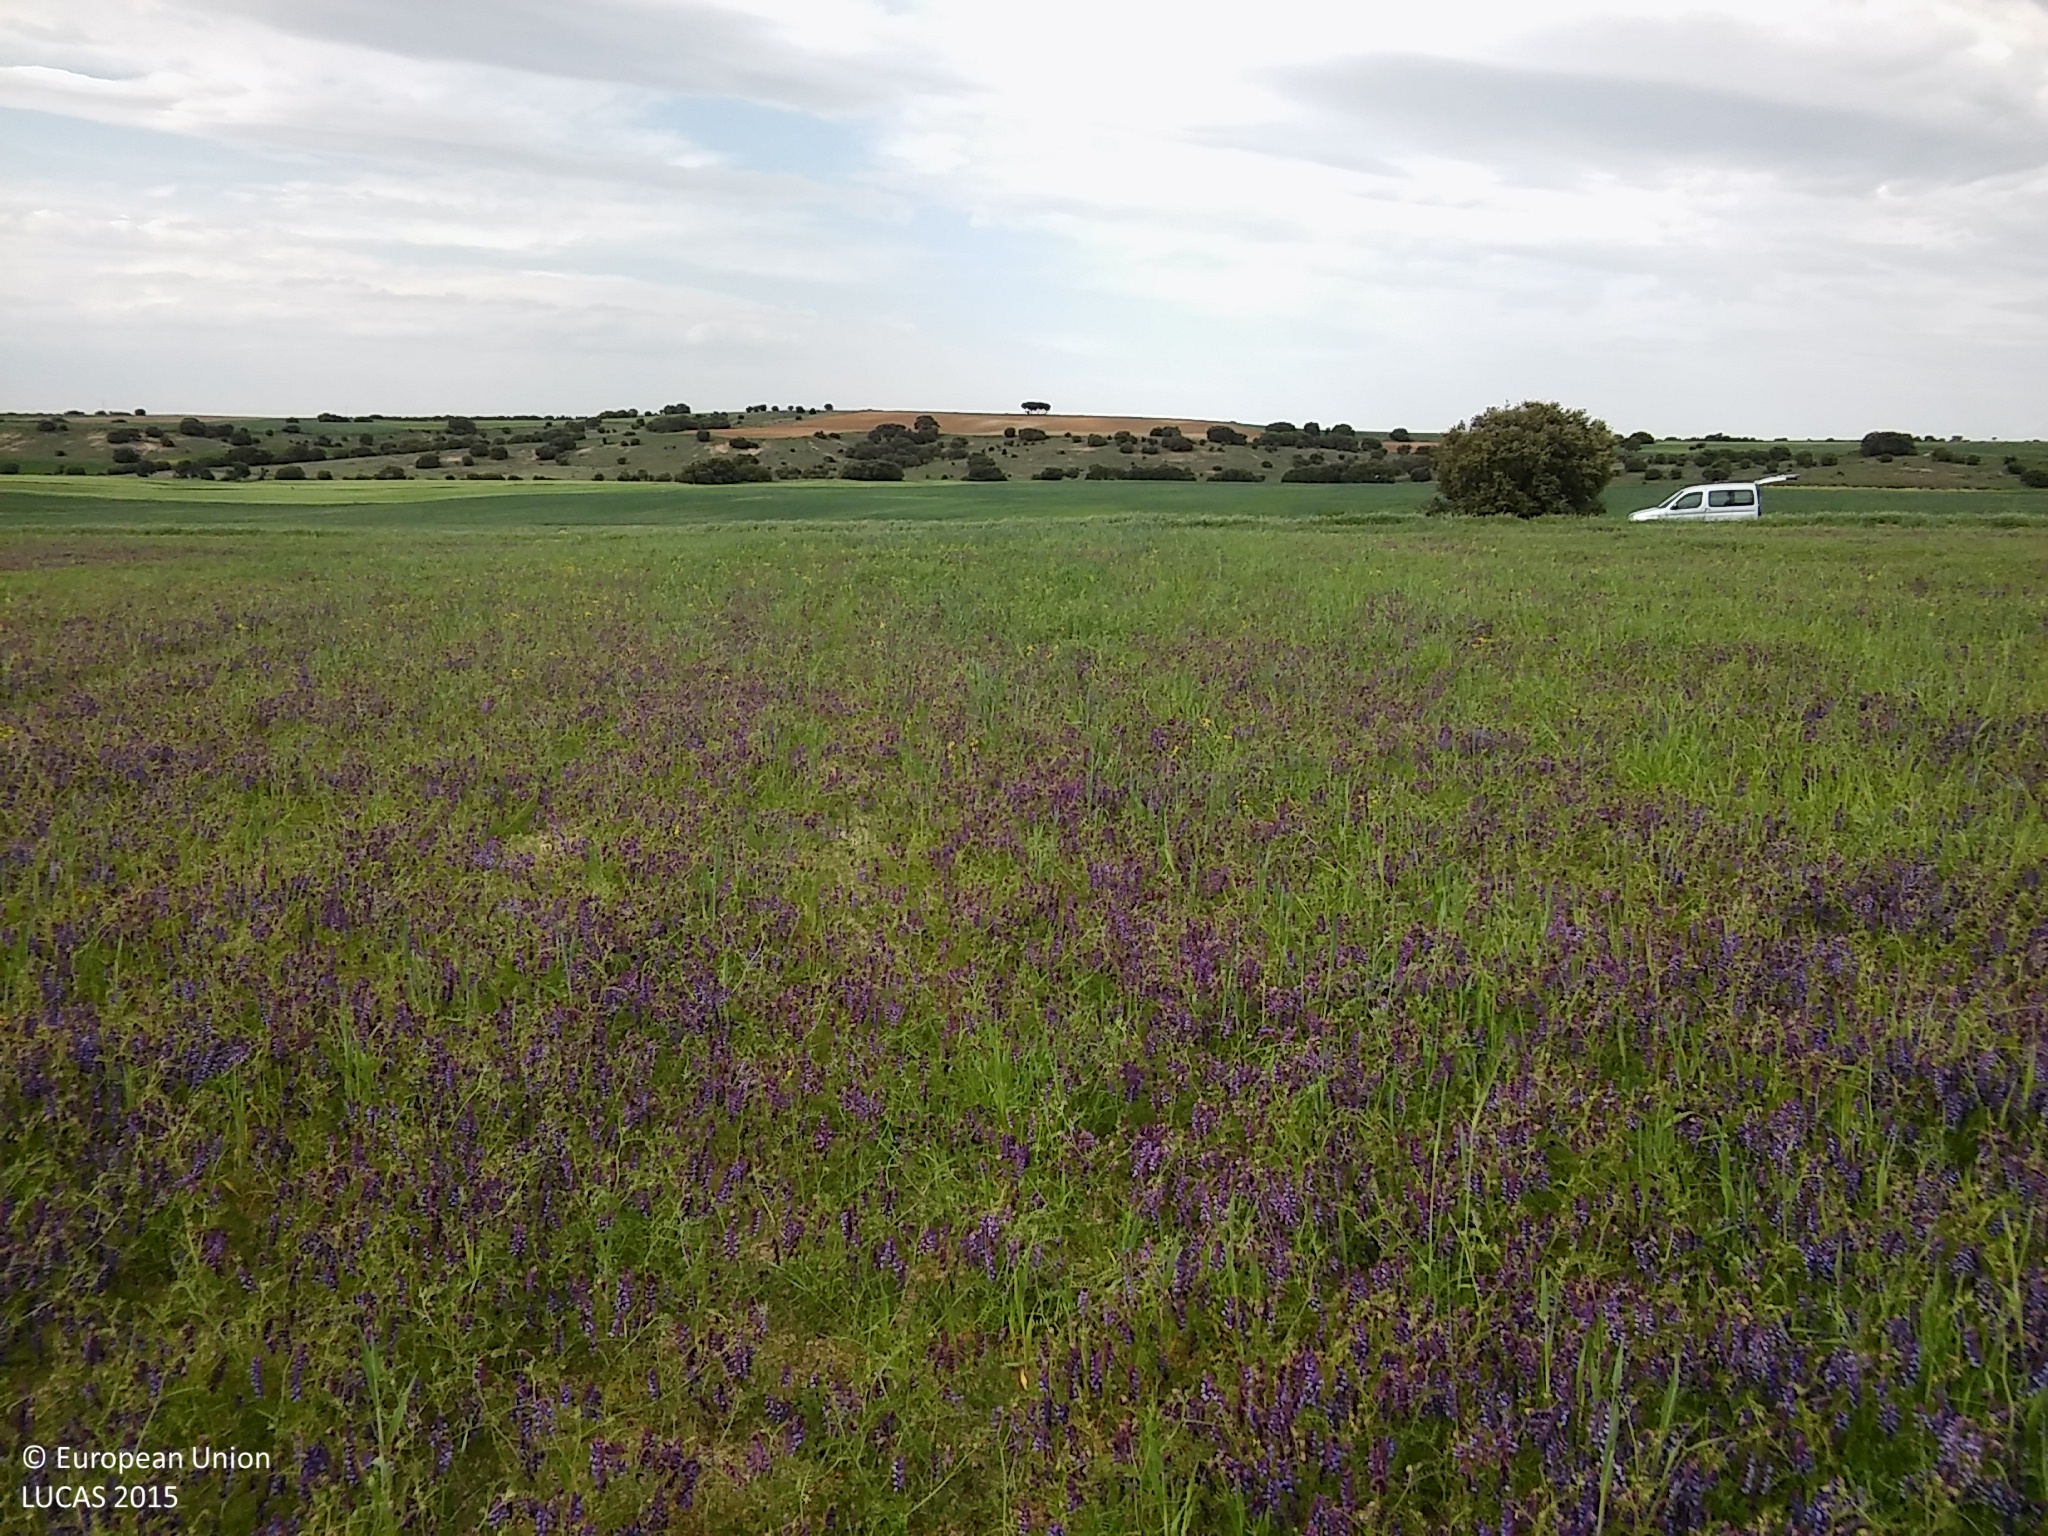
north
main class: Cropland
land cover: Dry pulses
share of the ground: > 75 %
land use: Agriculture (excluding fallow land and kitchen gardens)
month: May
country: ES
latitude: 41.0606
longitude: -4.0805
